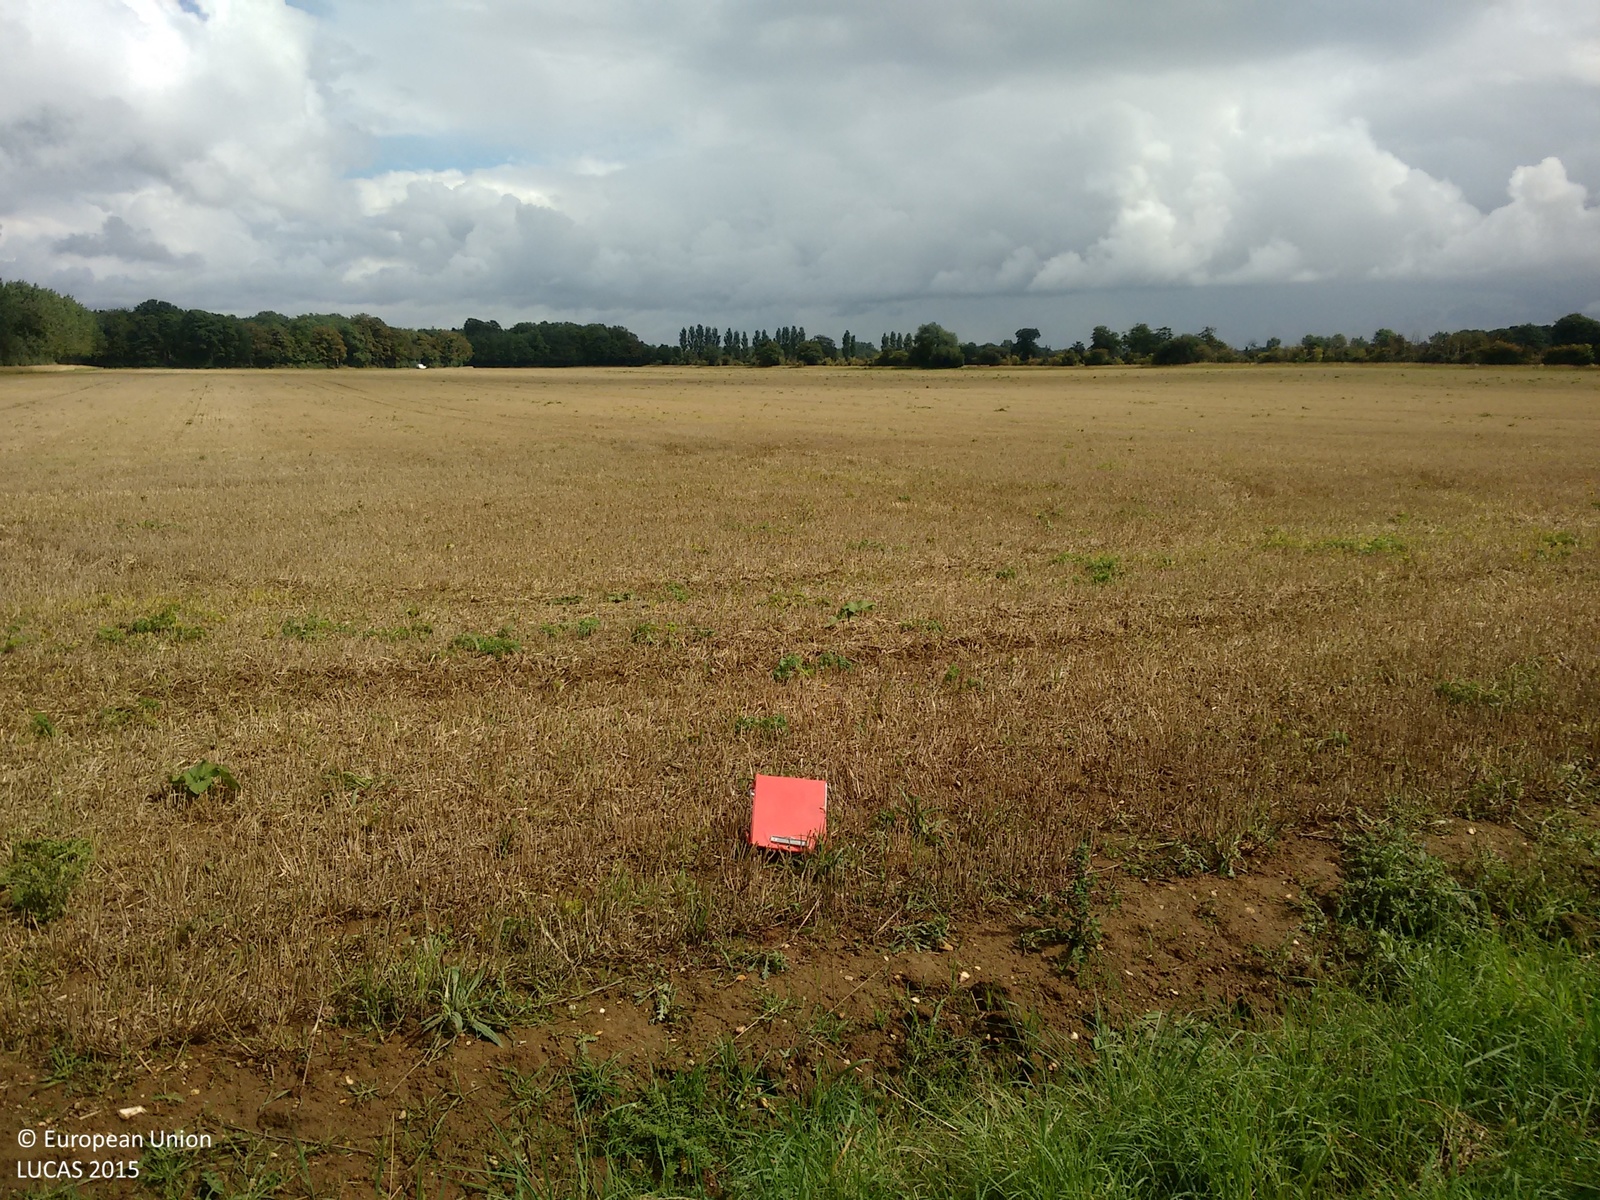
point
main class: Cropland
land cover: Barley
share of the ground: > 75 %
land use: Agriculture (excluding fallow land and kitchen gardens)
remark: Harvested field
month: September
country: GB
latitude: 52.2797
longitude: 0.4296
